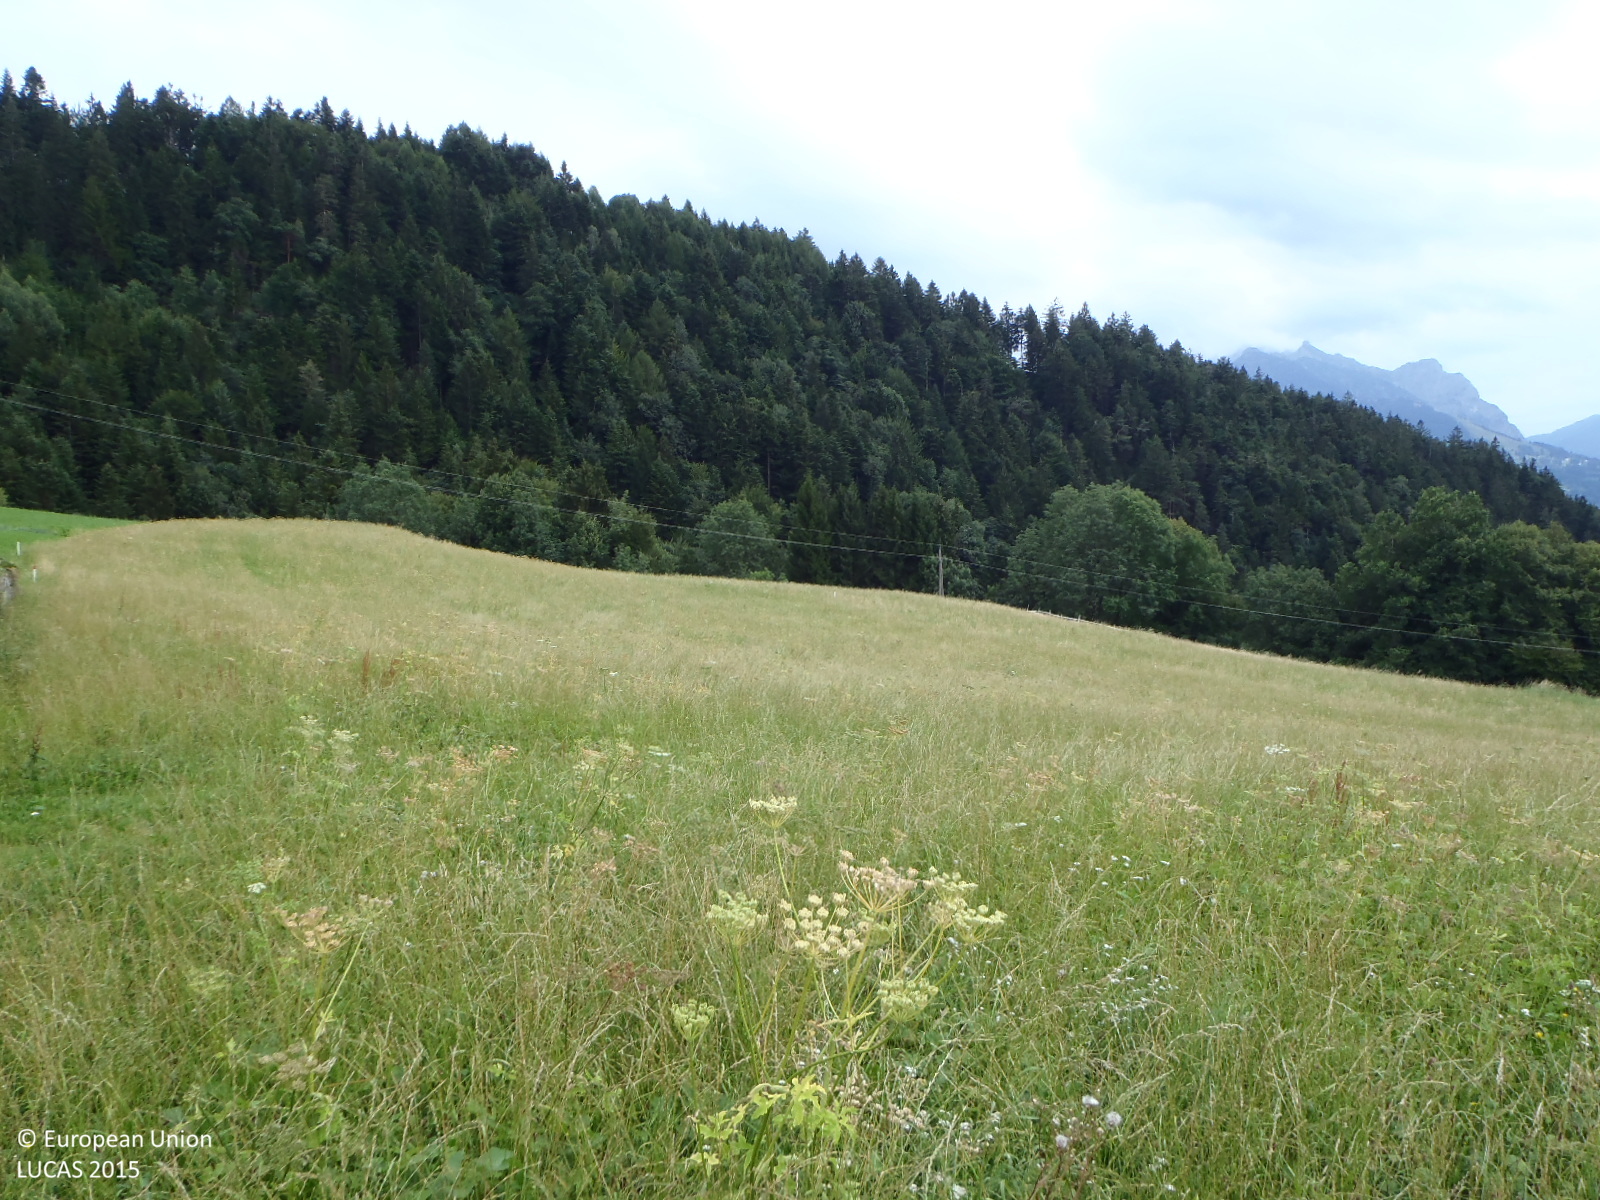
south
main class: Grassland
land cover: Grassland without tree/shrub cover
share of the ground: > 75 %
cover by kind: herbaceous plants 100 %
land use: Agriculture (excluding fallow land and kitchen gardens)
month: July
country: AT
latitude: 47.2511
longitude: 9.6700
